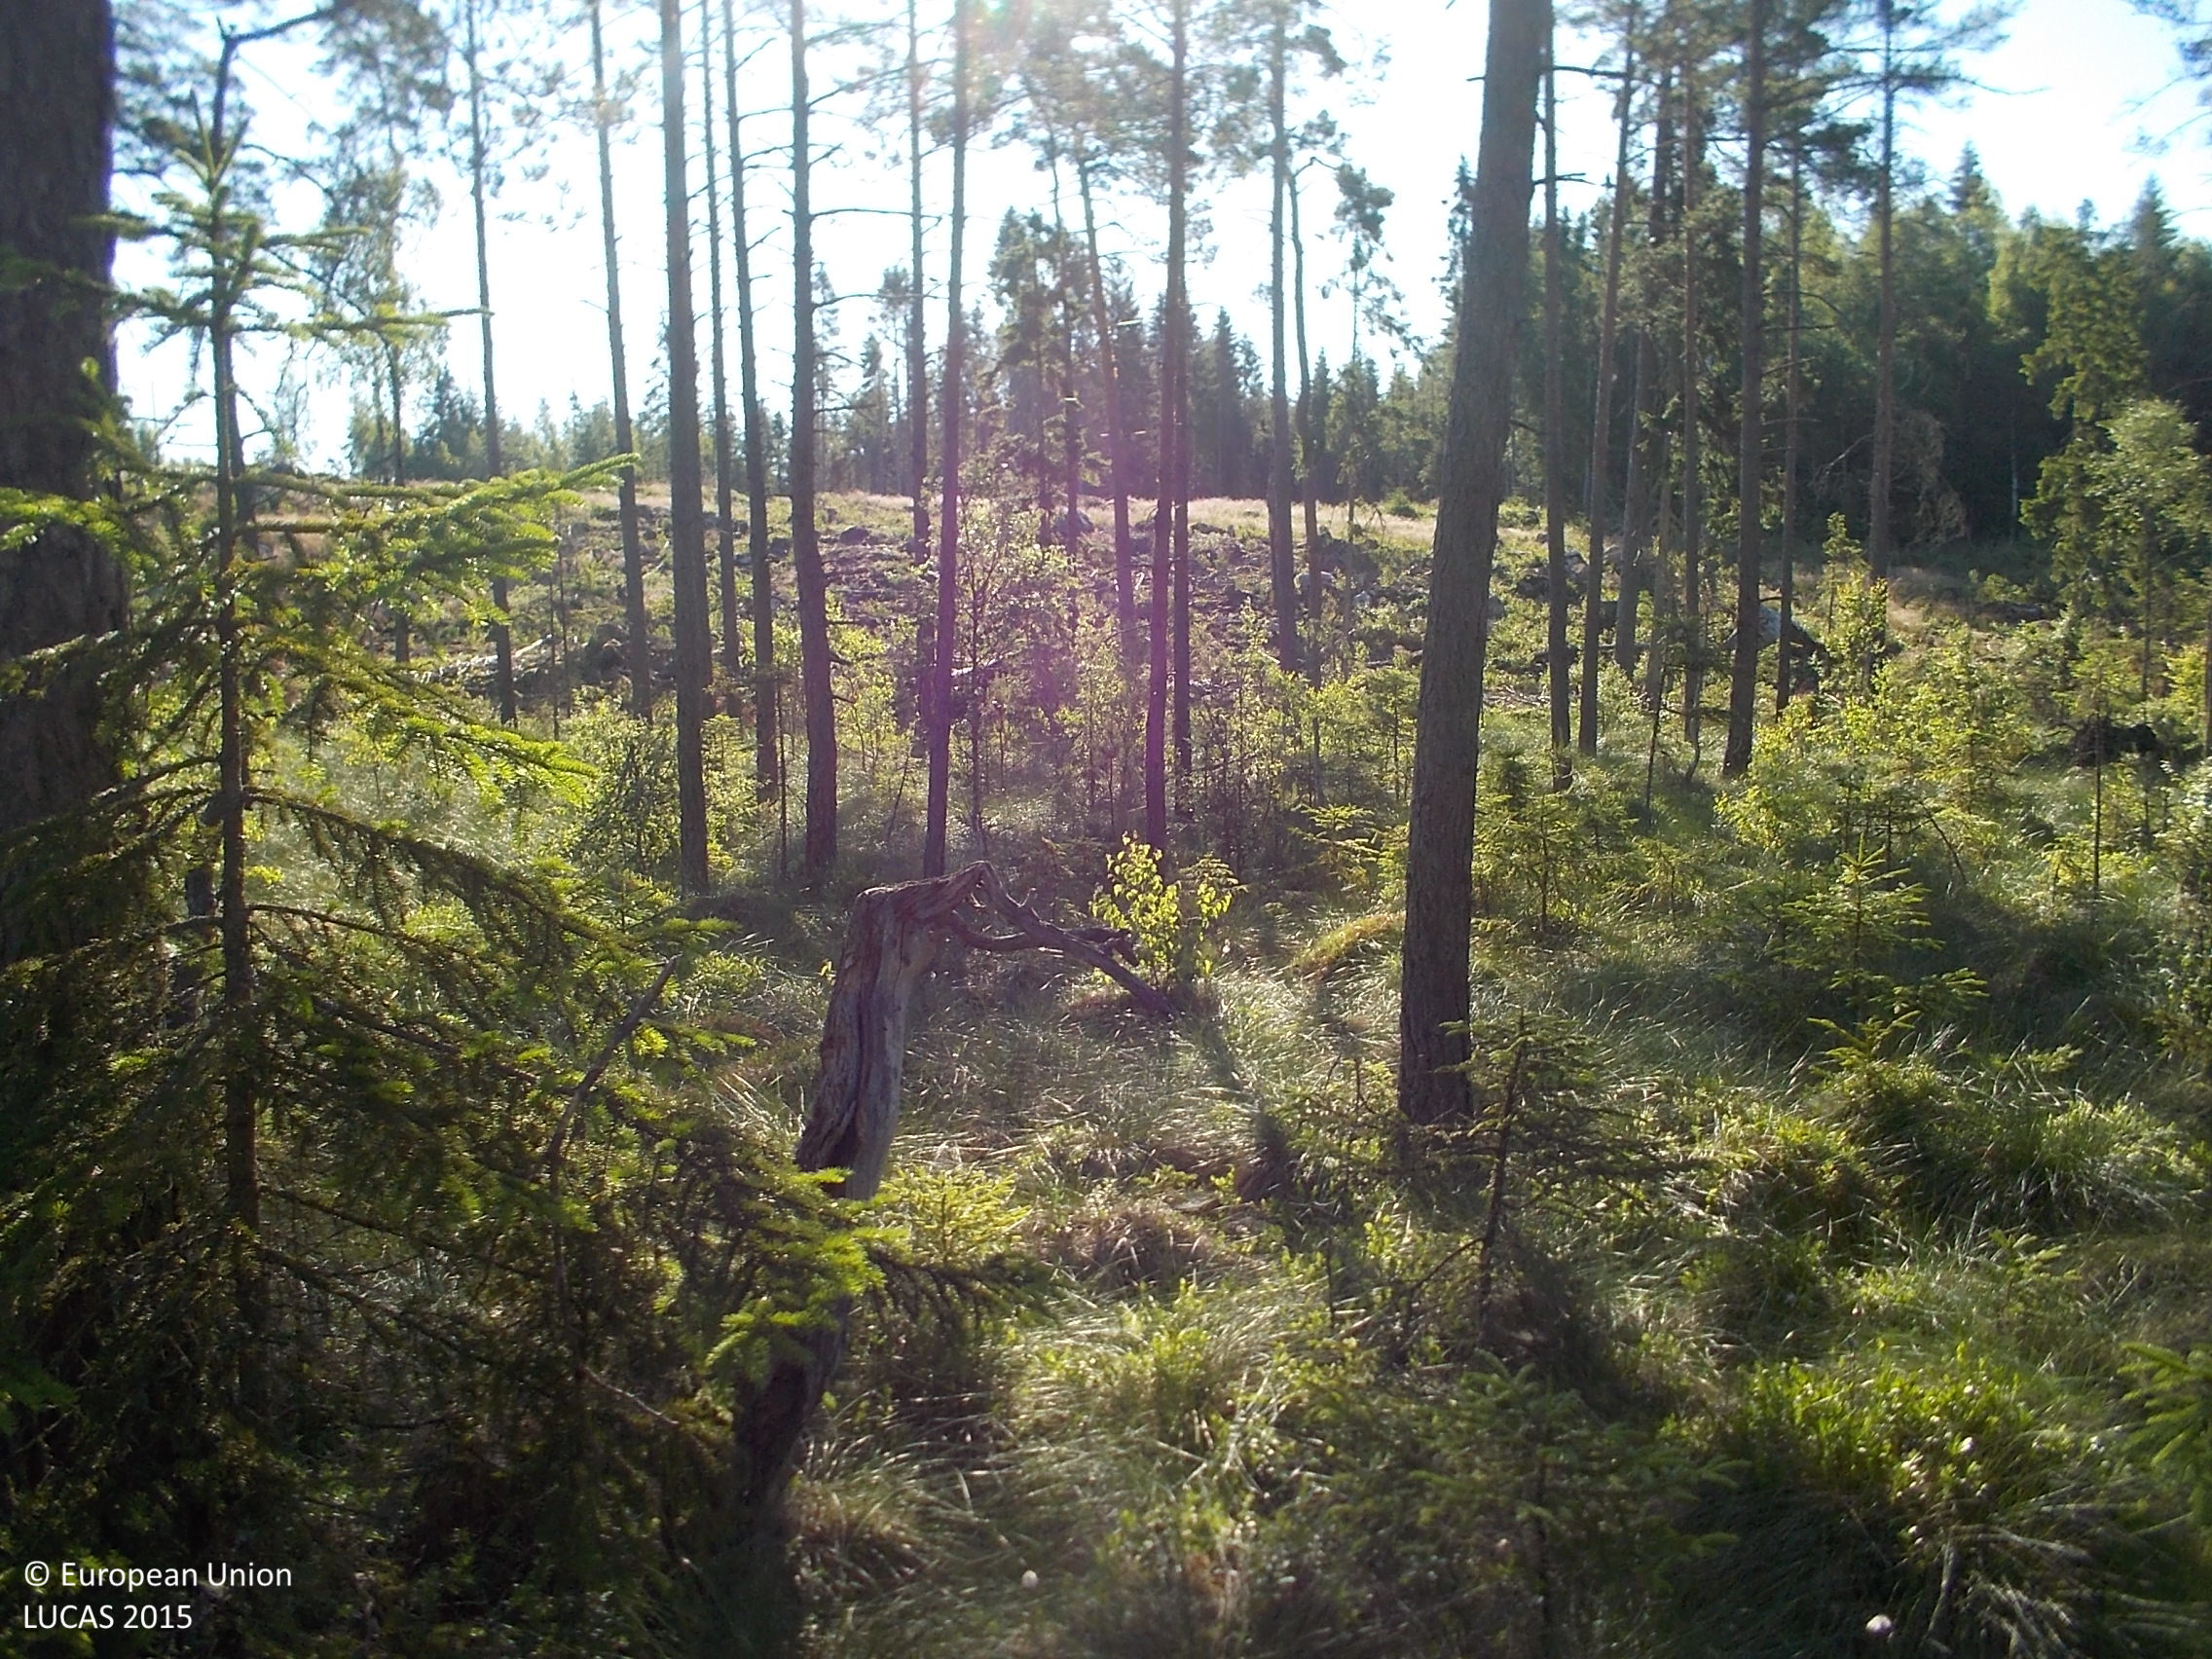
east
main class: Woodland
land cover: Pine dominated coniferous woodland
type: boreal forest
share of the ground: 50 - 75 %
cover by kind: coniferous forest trees 60 %, herbaceous plants 35 %, lichens and mosses 5 %
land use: Forestry
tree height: > 5 m
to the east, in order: Pine dominated coniferous woodland; Spruce dominated mixed woodland; Spruce dominated coniferous woodland
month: July
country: SE
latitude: 57.2465
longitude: 13.1614
